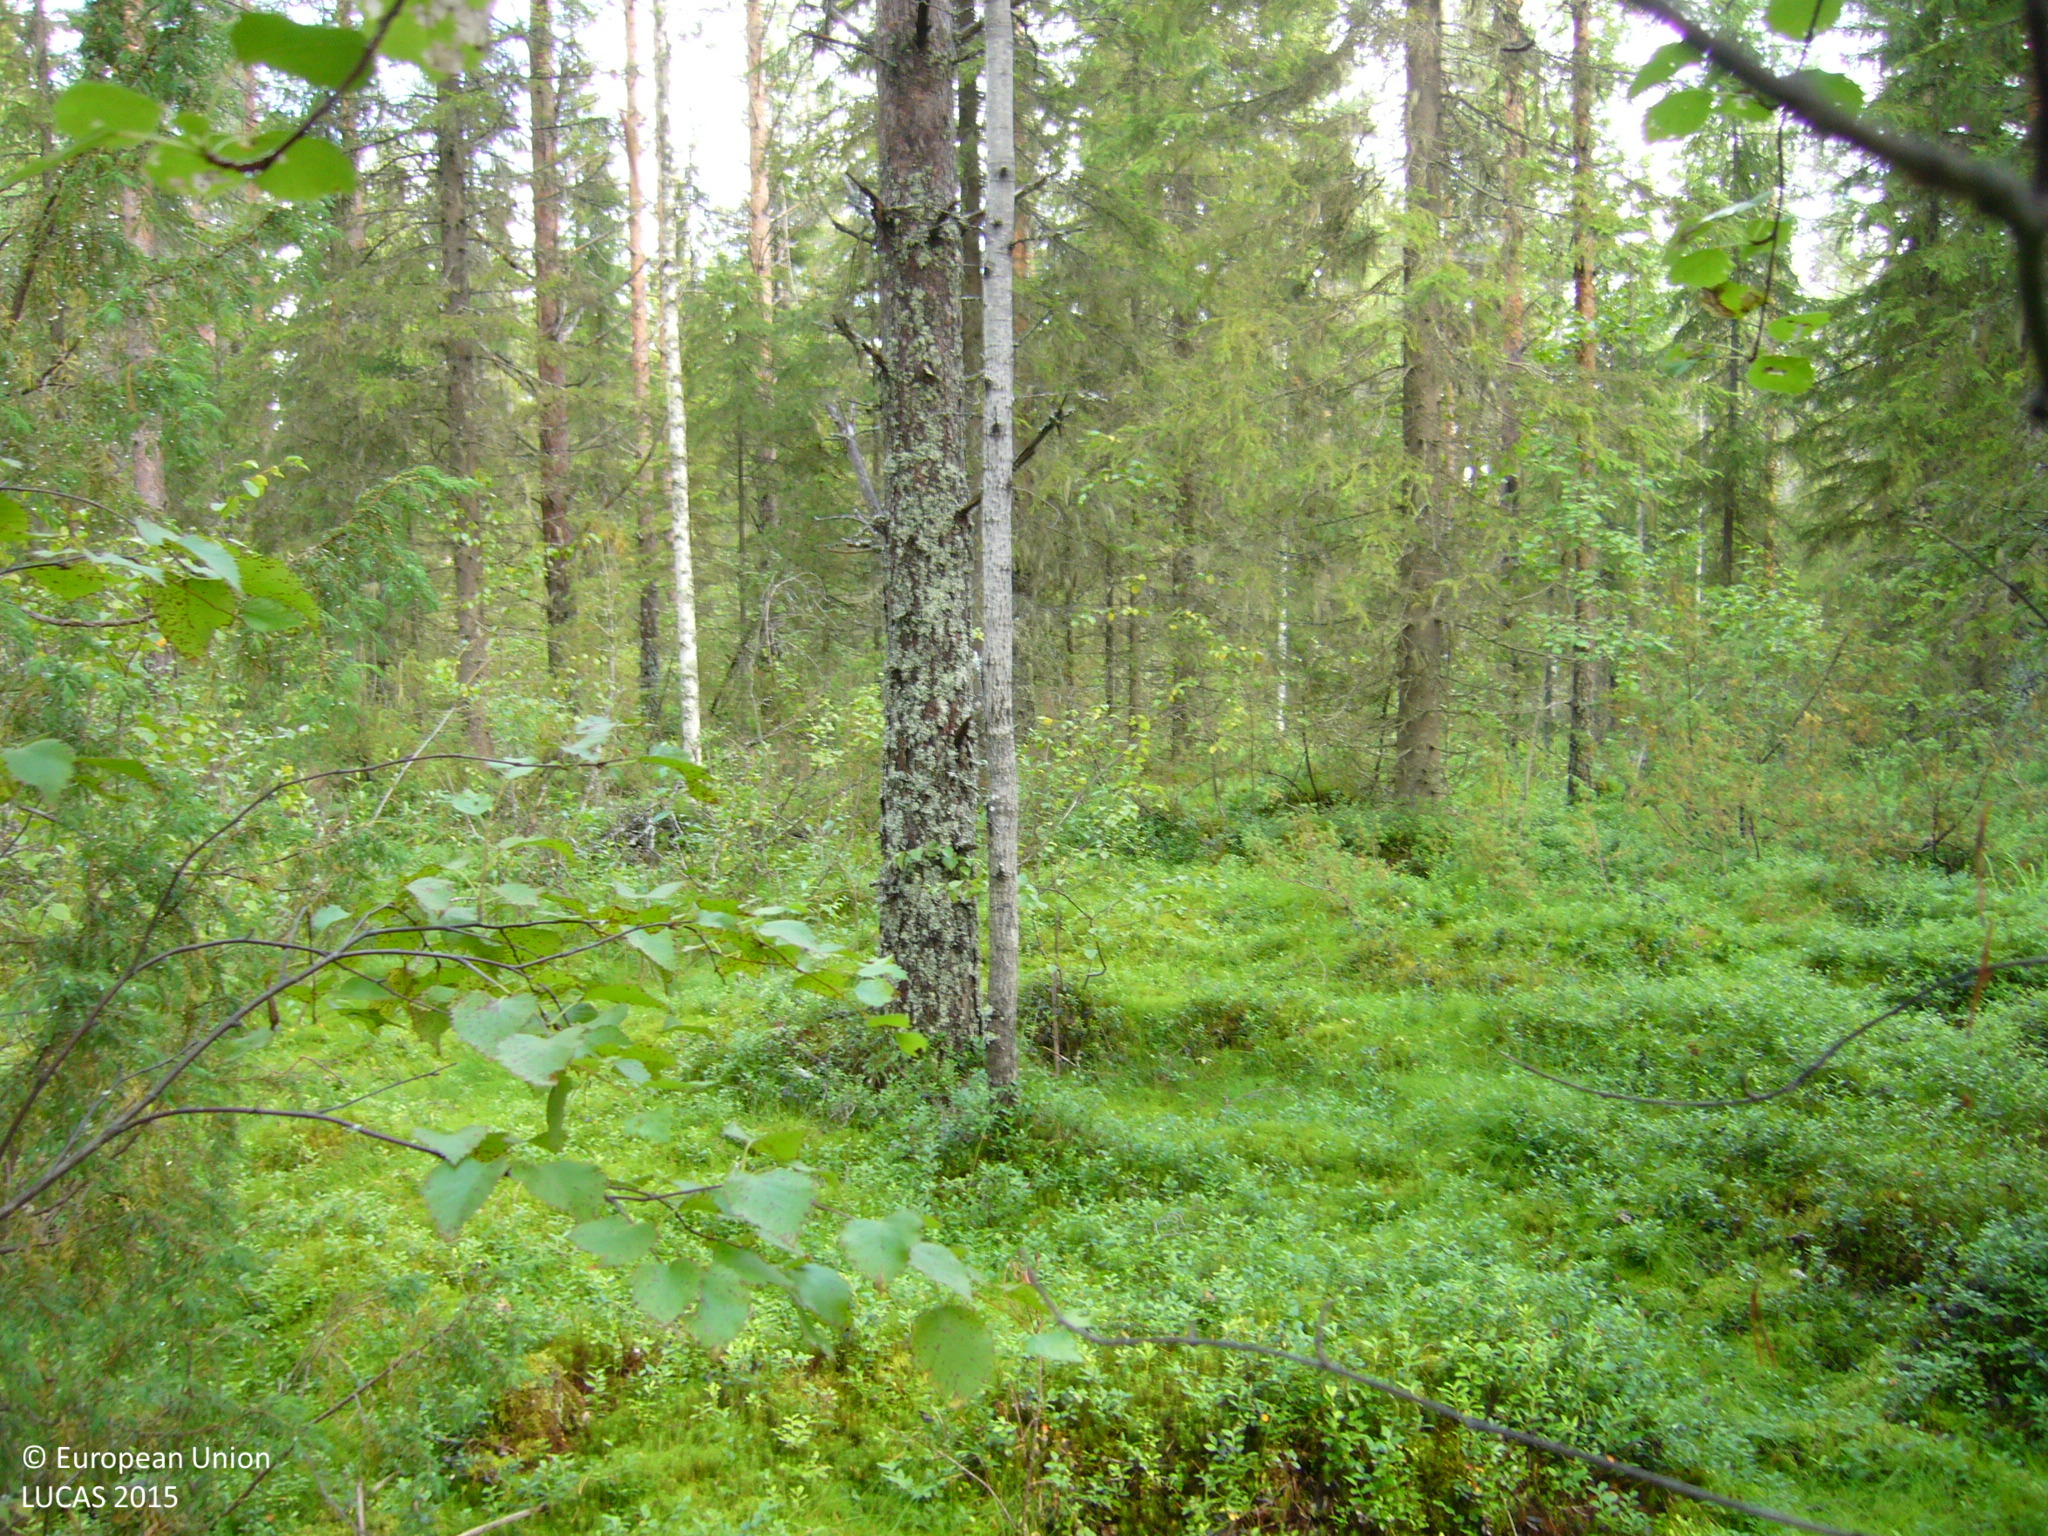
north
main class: Woodland
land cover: Spruce dominated coniferous woodland
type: boreal forest
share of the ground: > 75 %
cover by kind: coniferous forest trees 60 %, shrubs 25 %, broadleaved forest trees 15 %
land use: Forestry
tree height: > 5 m
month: July
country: FI
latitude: 63.9070
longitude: 26.5689
